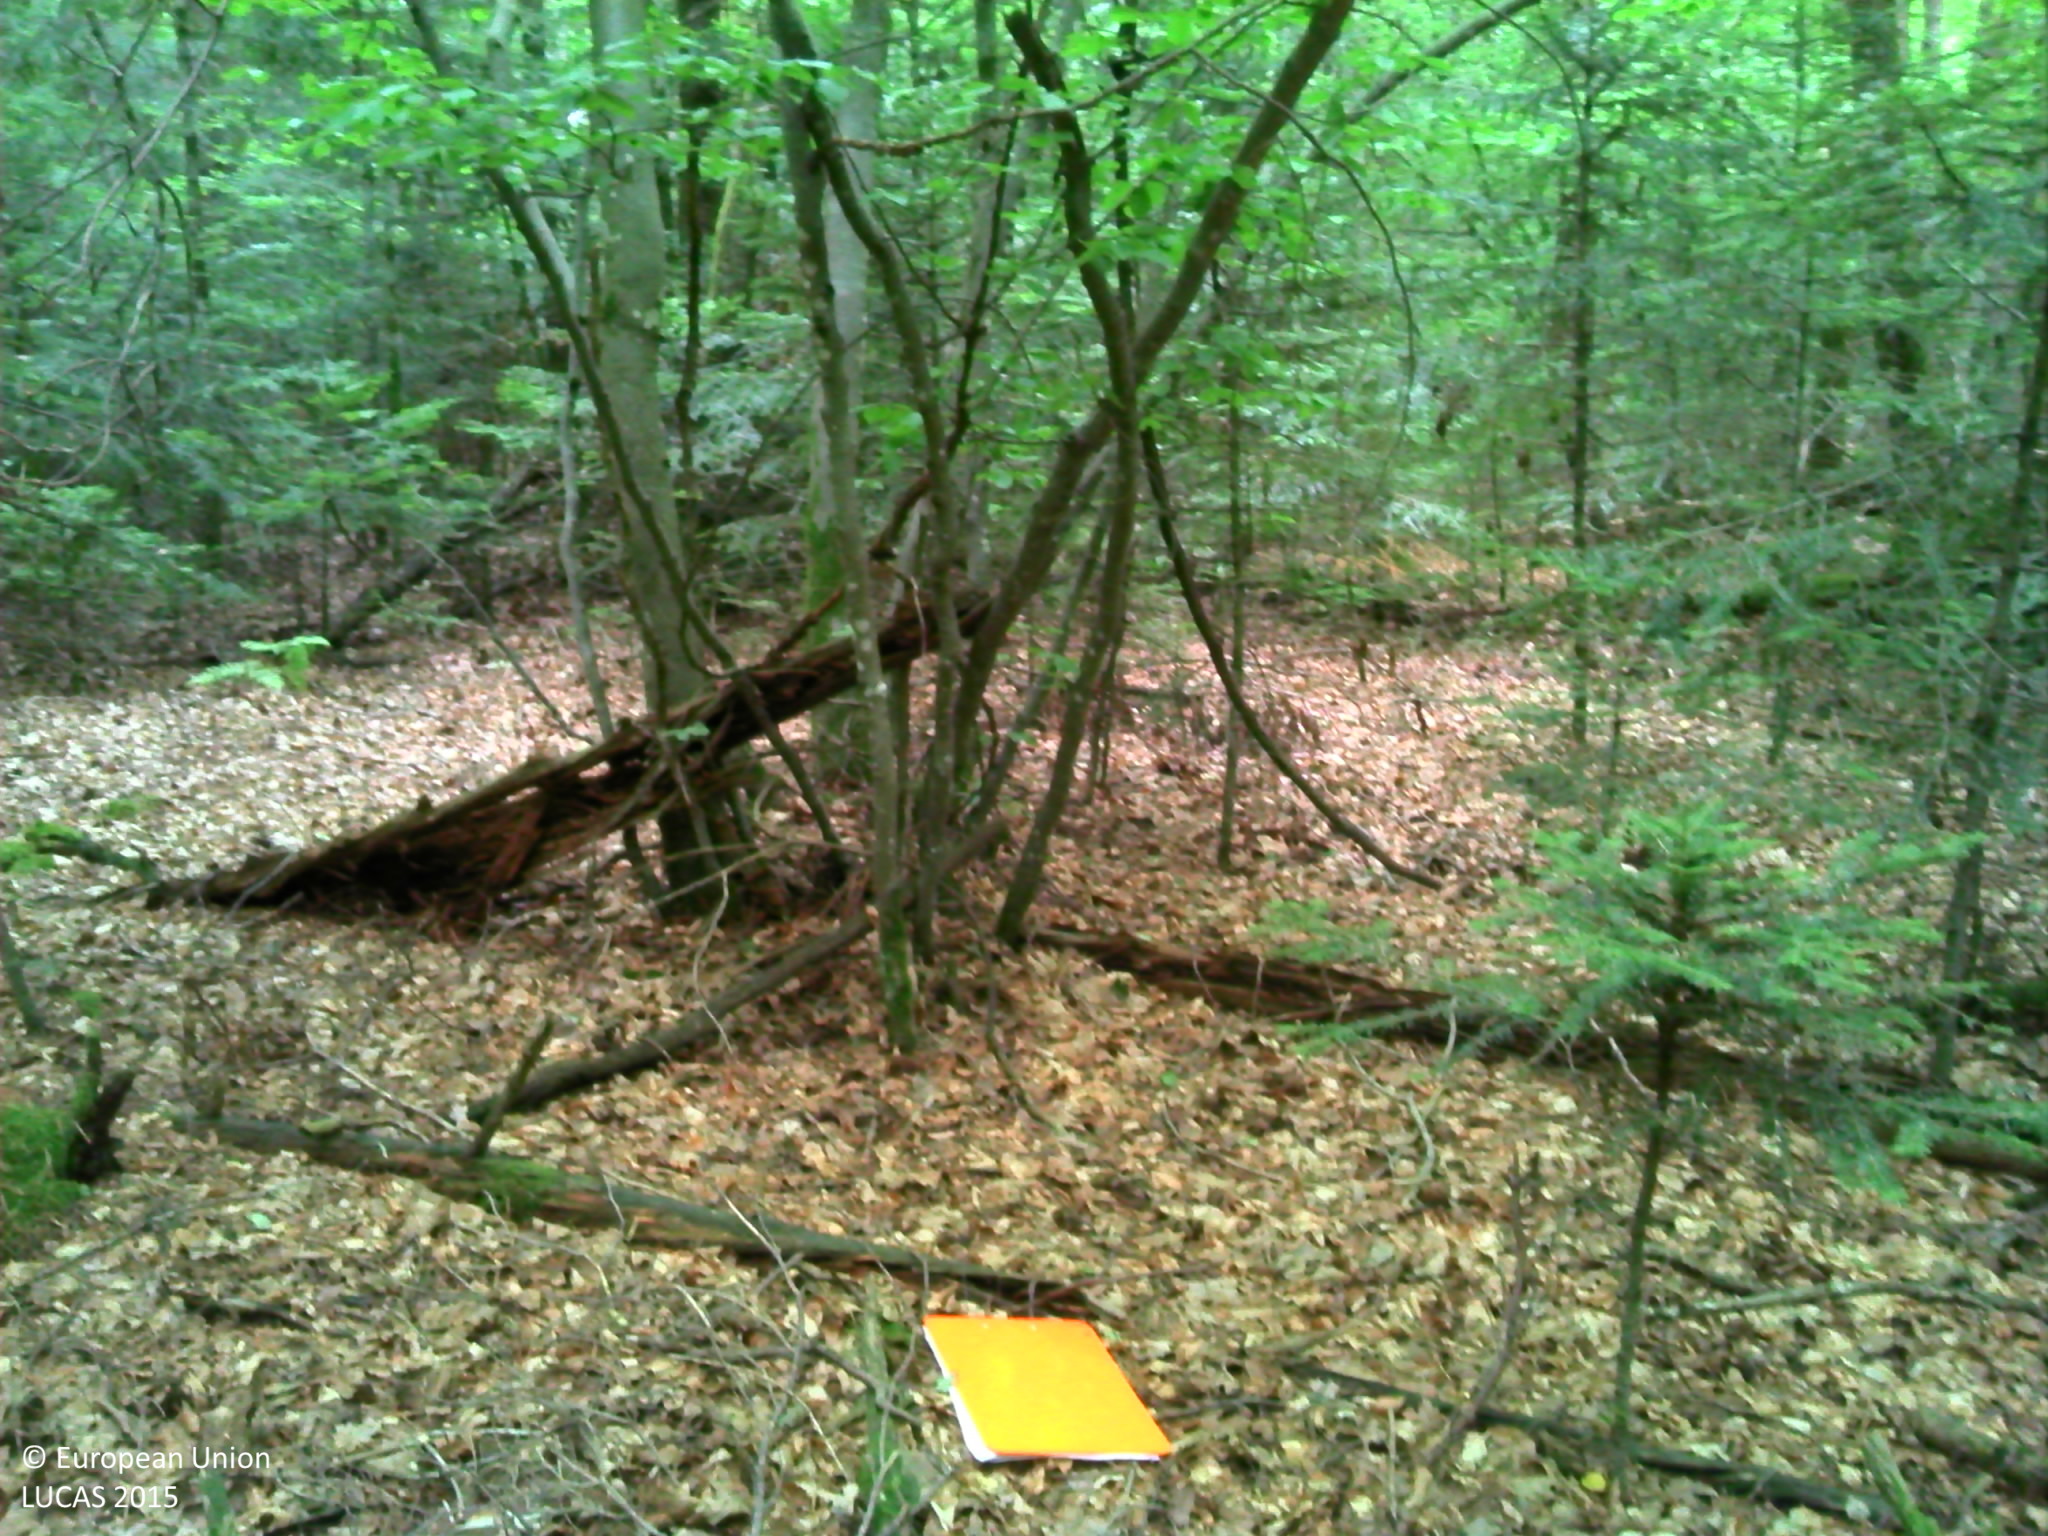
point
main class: Woodland
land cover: Spruce dominated mixed woodland
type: mesophytic deciduous forest
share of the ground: > 75 %
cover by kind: coniferous forest trees 55 %, broadleaved forest trees 25 %, herbaceous plants 10 %
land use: Forestry
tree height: > 5 m
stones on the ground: < 10 %
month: August
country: FR
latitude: 46.2247
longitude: 4.4399
